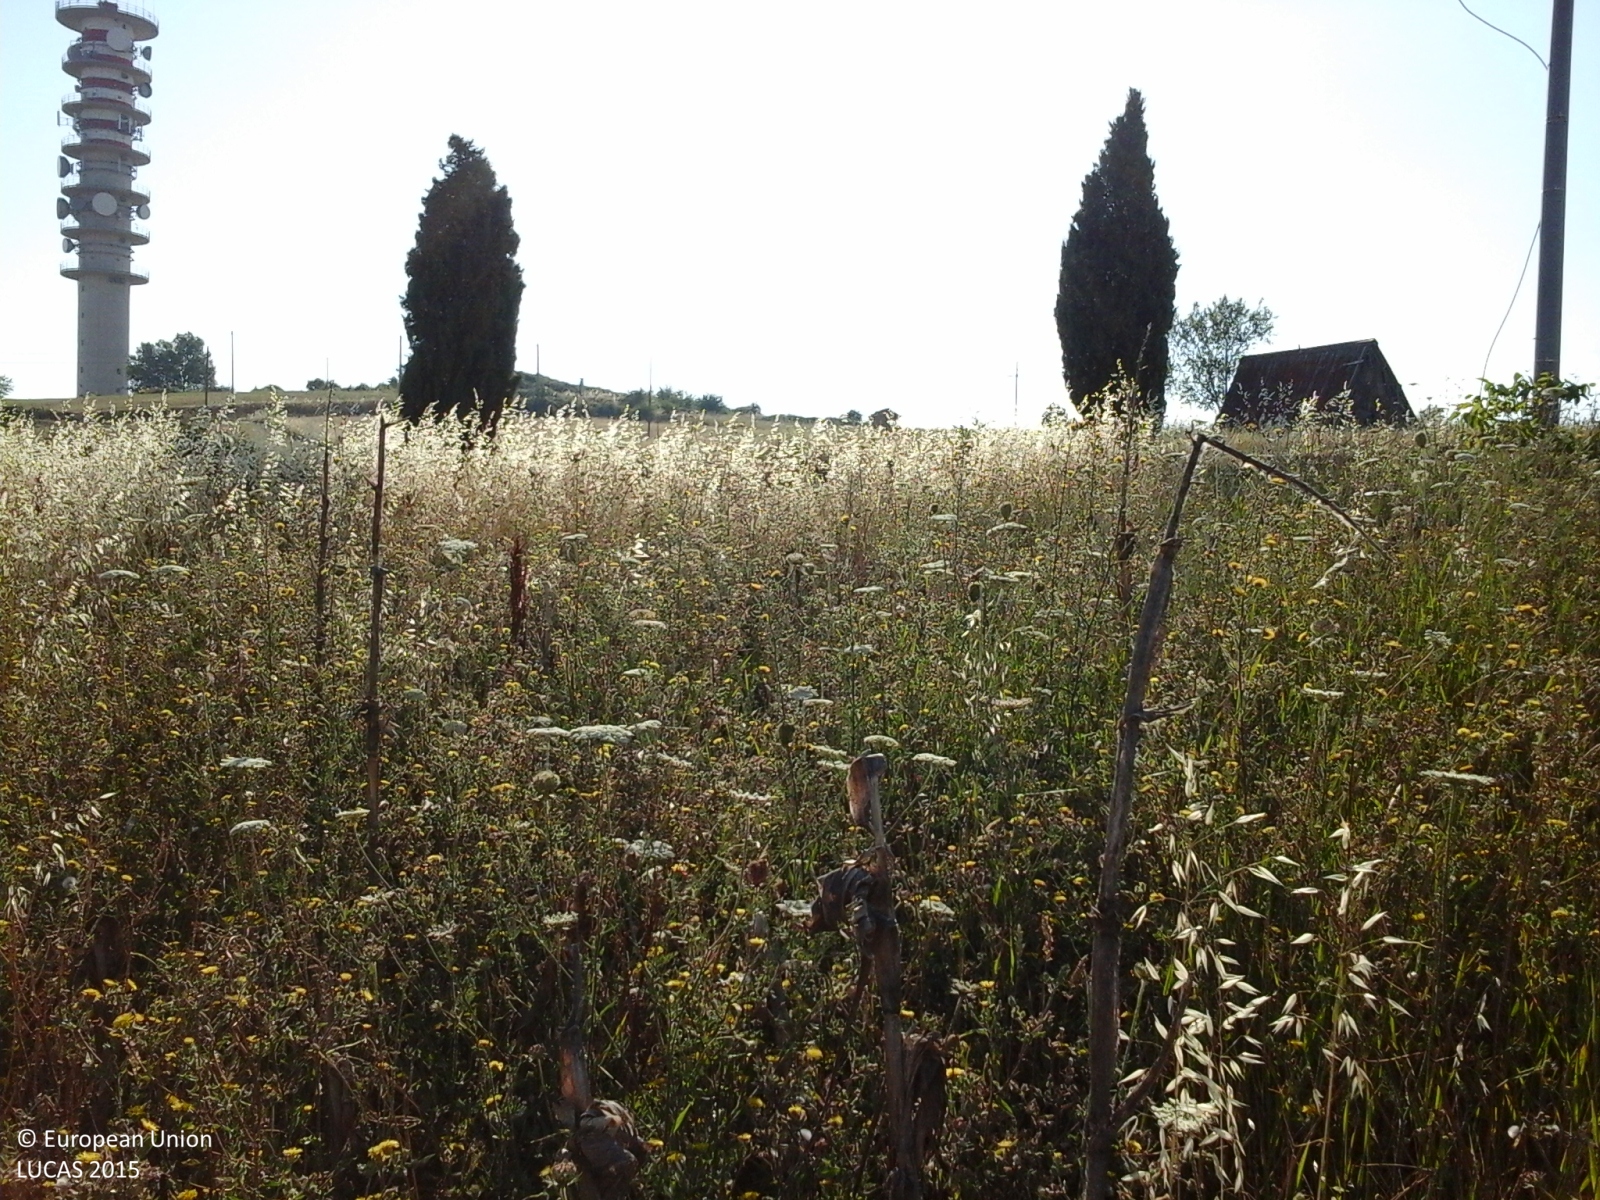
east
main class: Grassland
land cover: Spontaneously vegetated surfaces
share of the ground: > 75 %
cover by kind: herbaceous plants 100 %
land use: Fallow land
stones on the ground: < 10 %
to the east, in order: Spontaneously vegetated surfaces; Electric lines; Spontaneously vegetated surfaces; Grass margins; Lines of trees; Artificial constructions; Paved roads, cycling and walking lanes; Artificial constructions; Grass margins; Temporary grasslands; Electric lines; Spontaneously vegetated surfaces; Durum wheat; Tracks; Durum wheat; Spontaneously vegetated surfaces
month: July
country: IT
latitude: 41.6412
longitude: 14.6782
